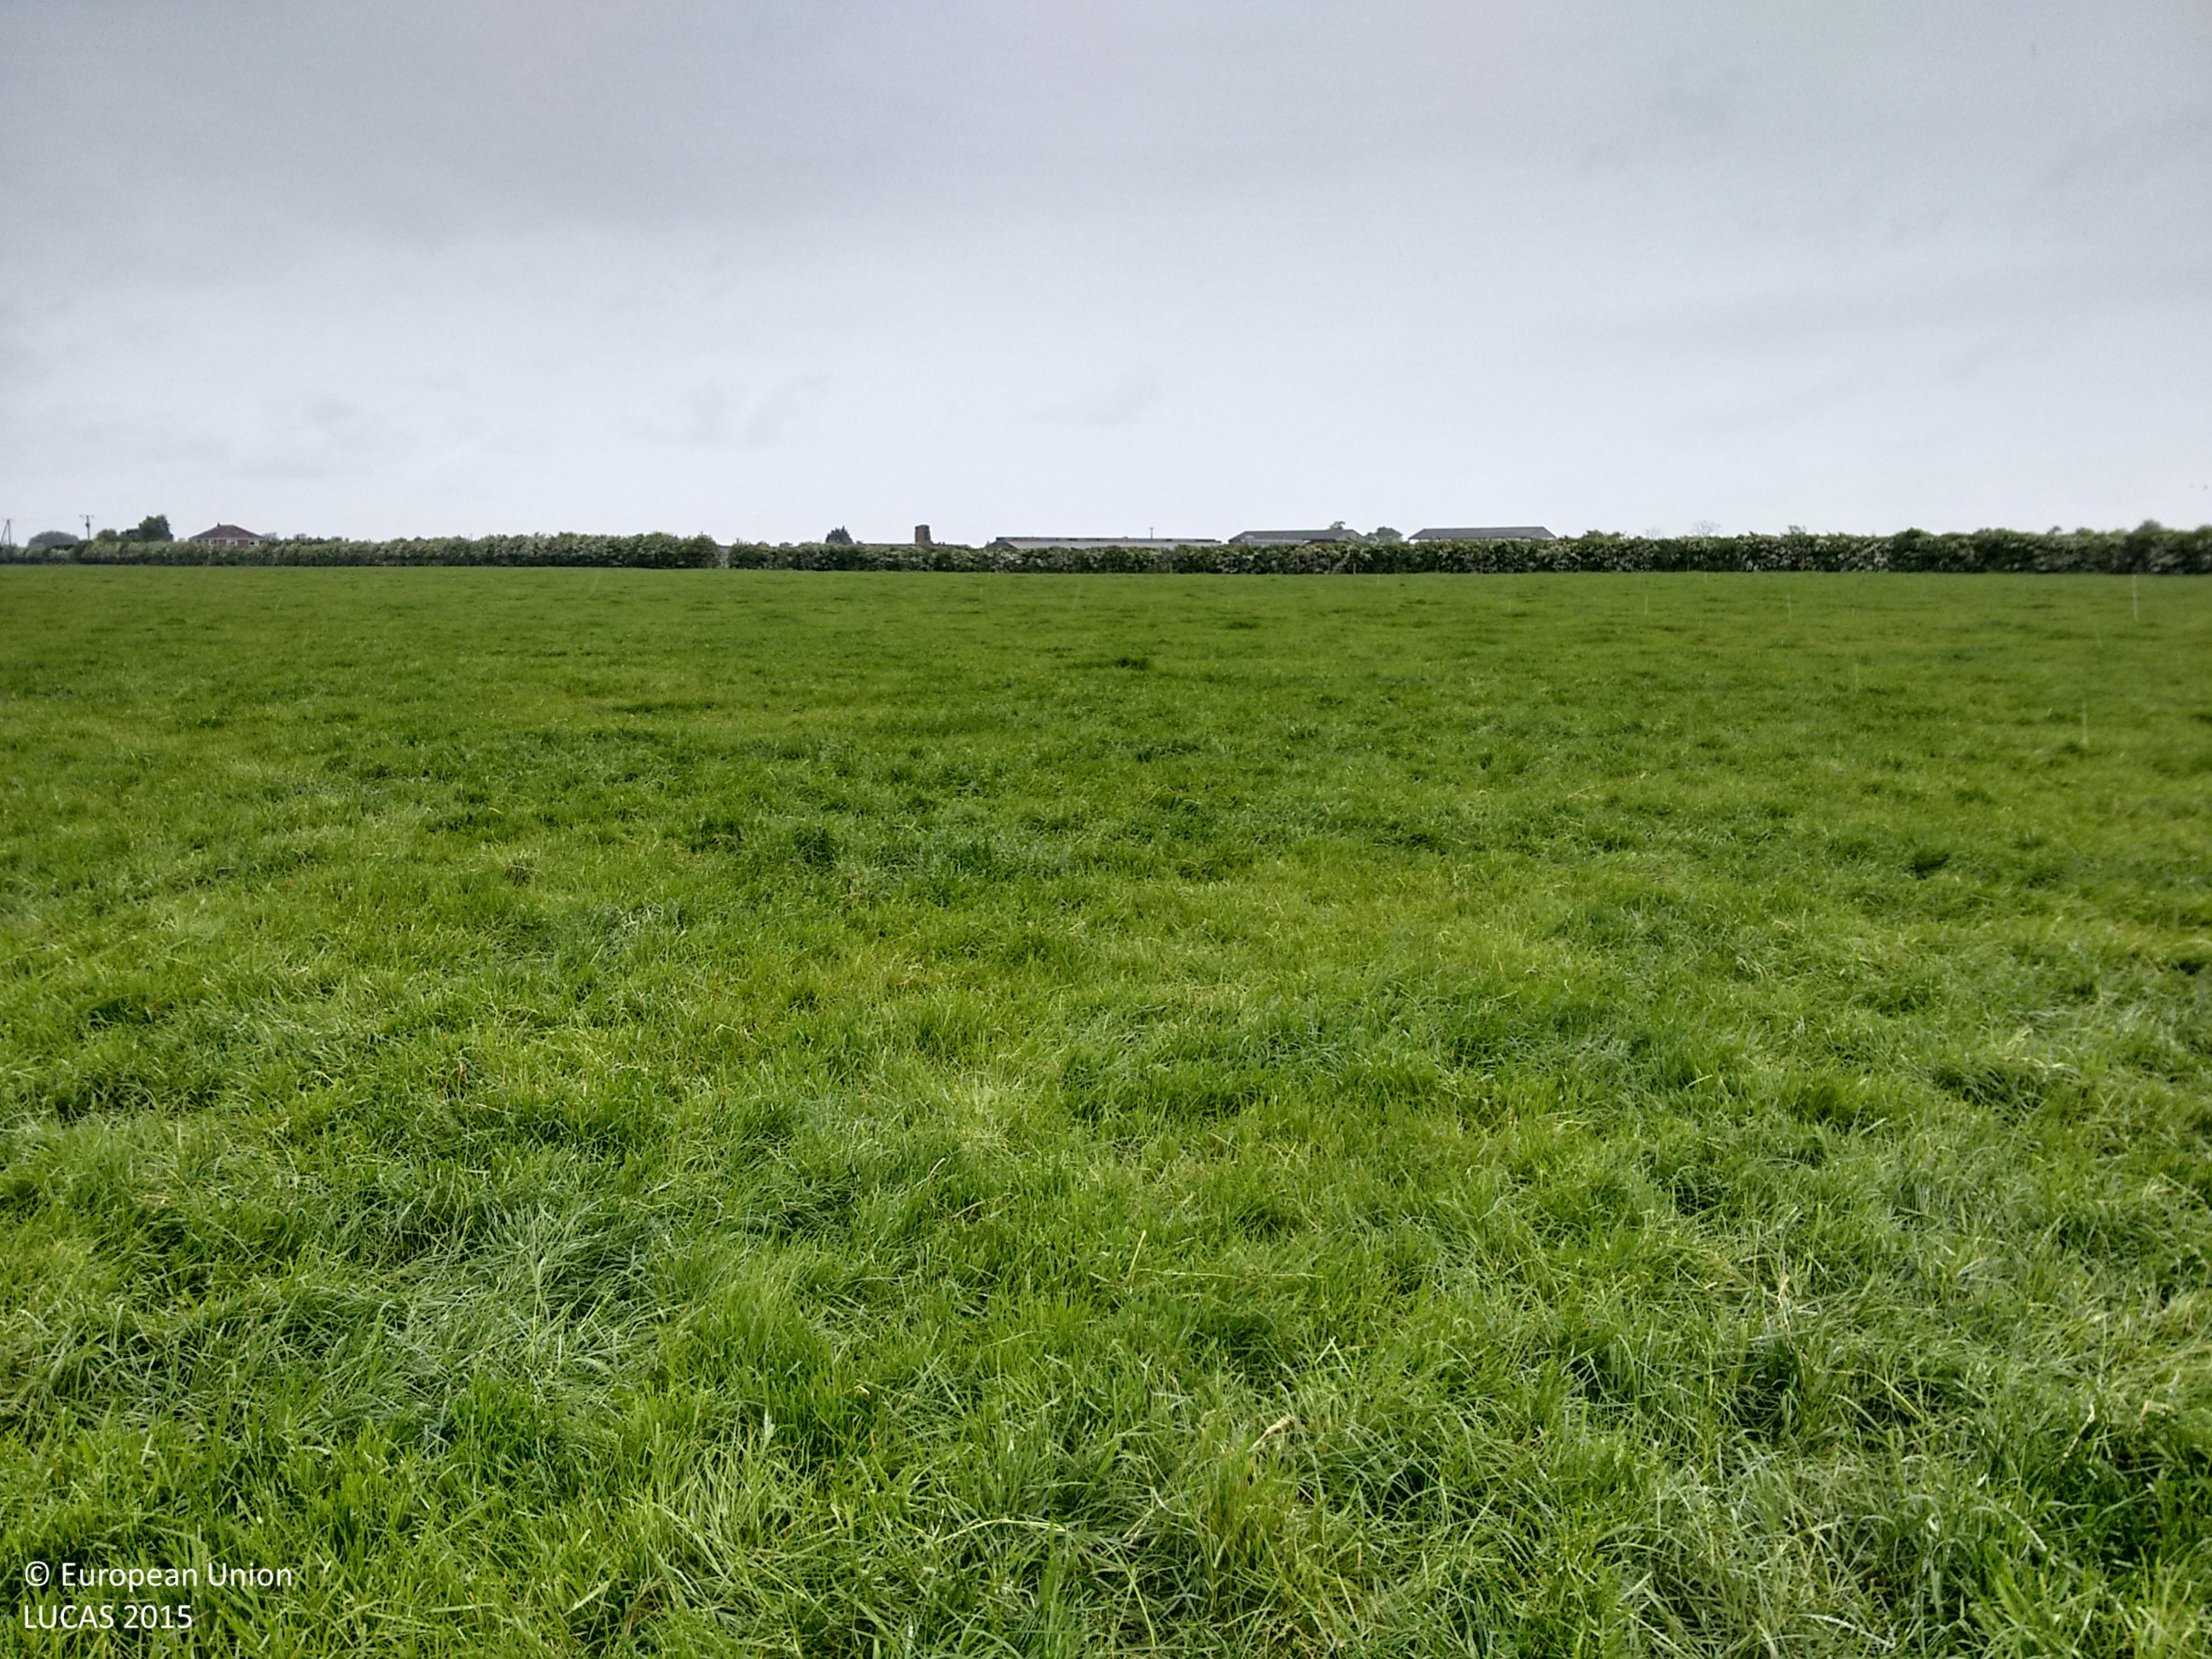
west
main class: Grassland
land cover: Grassland without tree/shrub cover
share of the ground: > 75 %
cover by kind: herbaceous plants 100 %
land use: Agriculture (excluding fallow land and kitchen gardens)
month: May
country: GB
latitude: 53.7057
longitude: -0.2904
